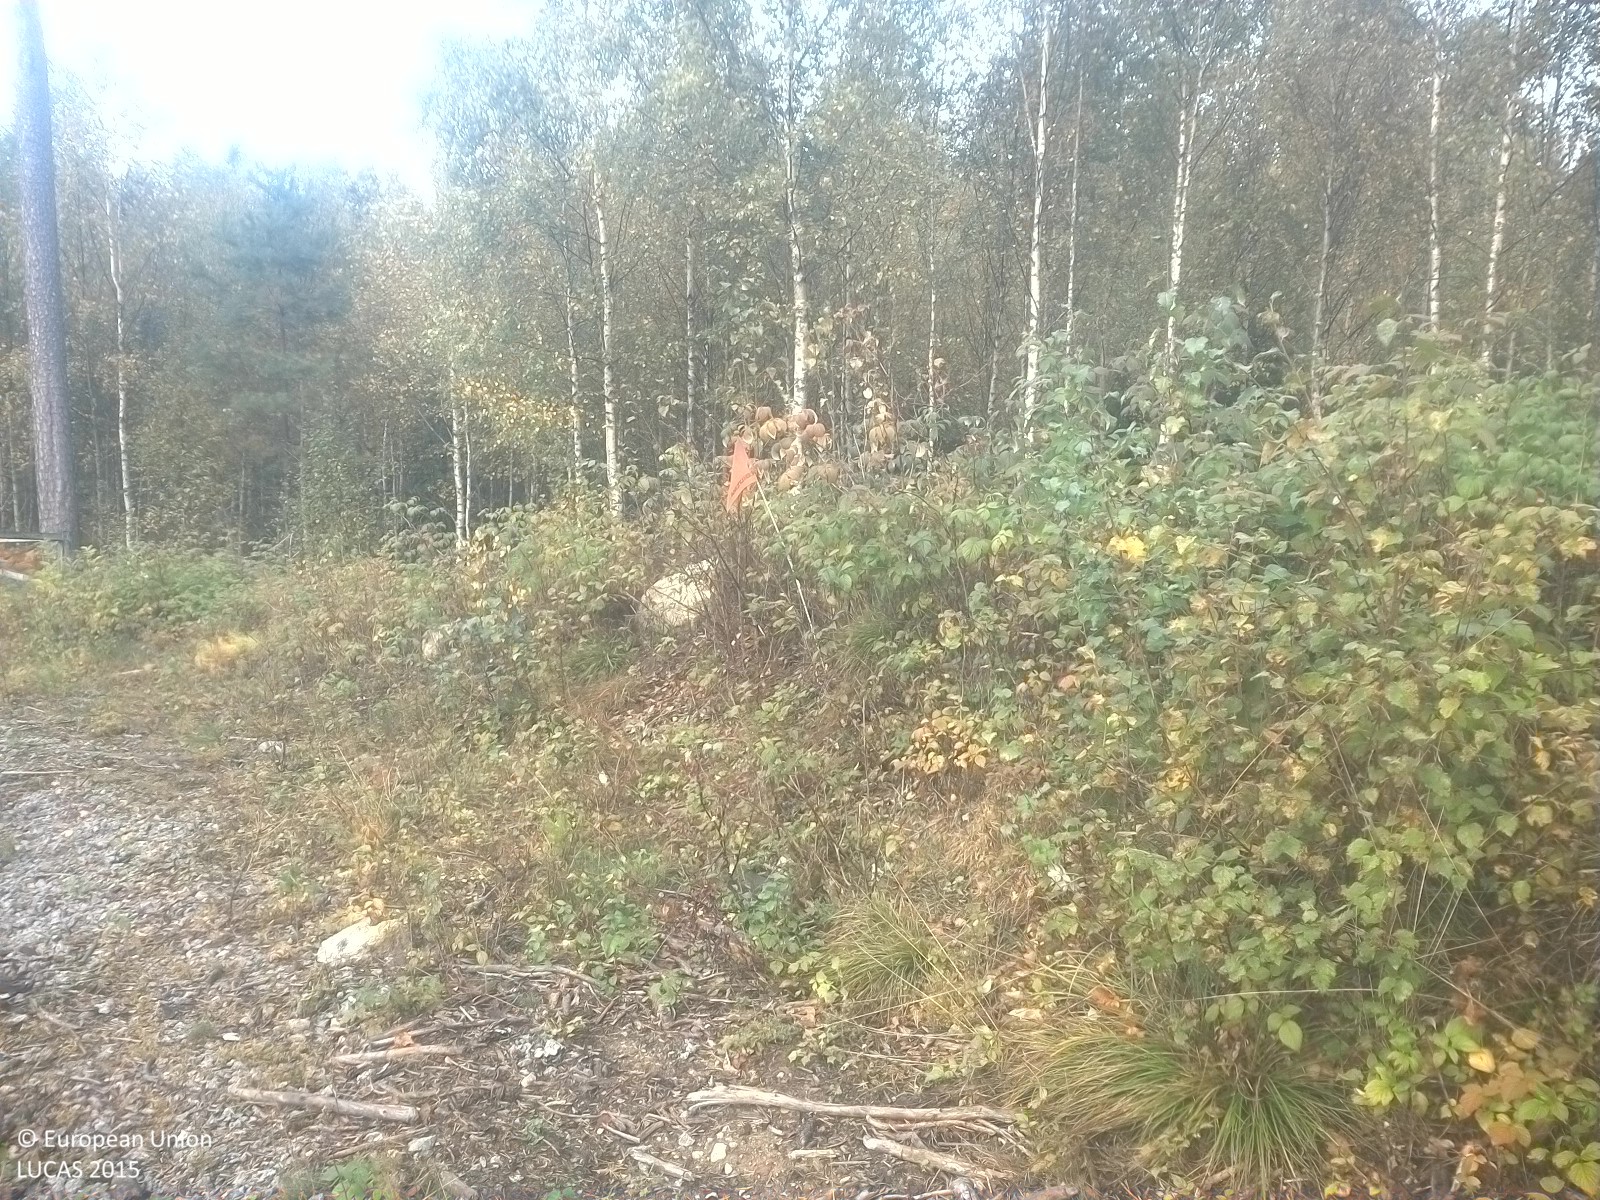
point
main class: Shrubland
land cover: Shrubland with sparse tree cover
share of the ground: > 75 %
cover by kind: shrubs 80 %, herbaceous plants 15 %, broadleaved forest trees 5 %
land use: Semi-natural and natural areas not in use
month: September
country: SE
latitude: 58.8565
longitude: 15.6967
